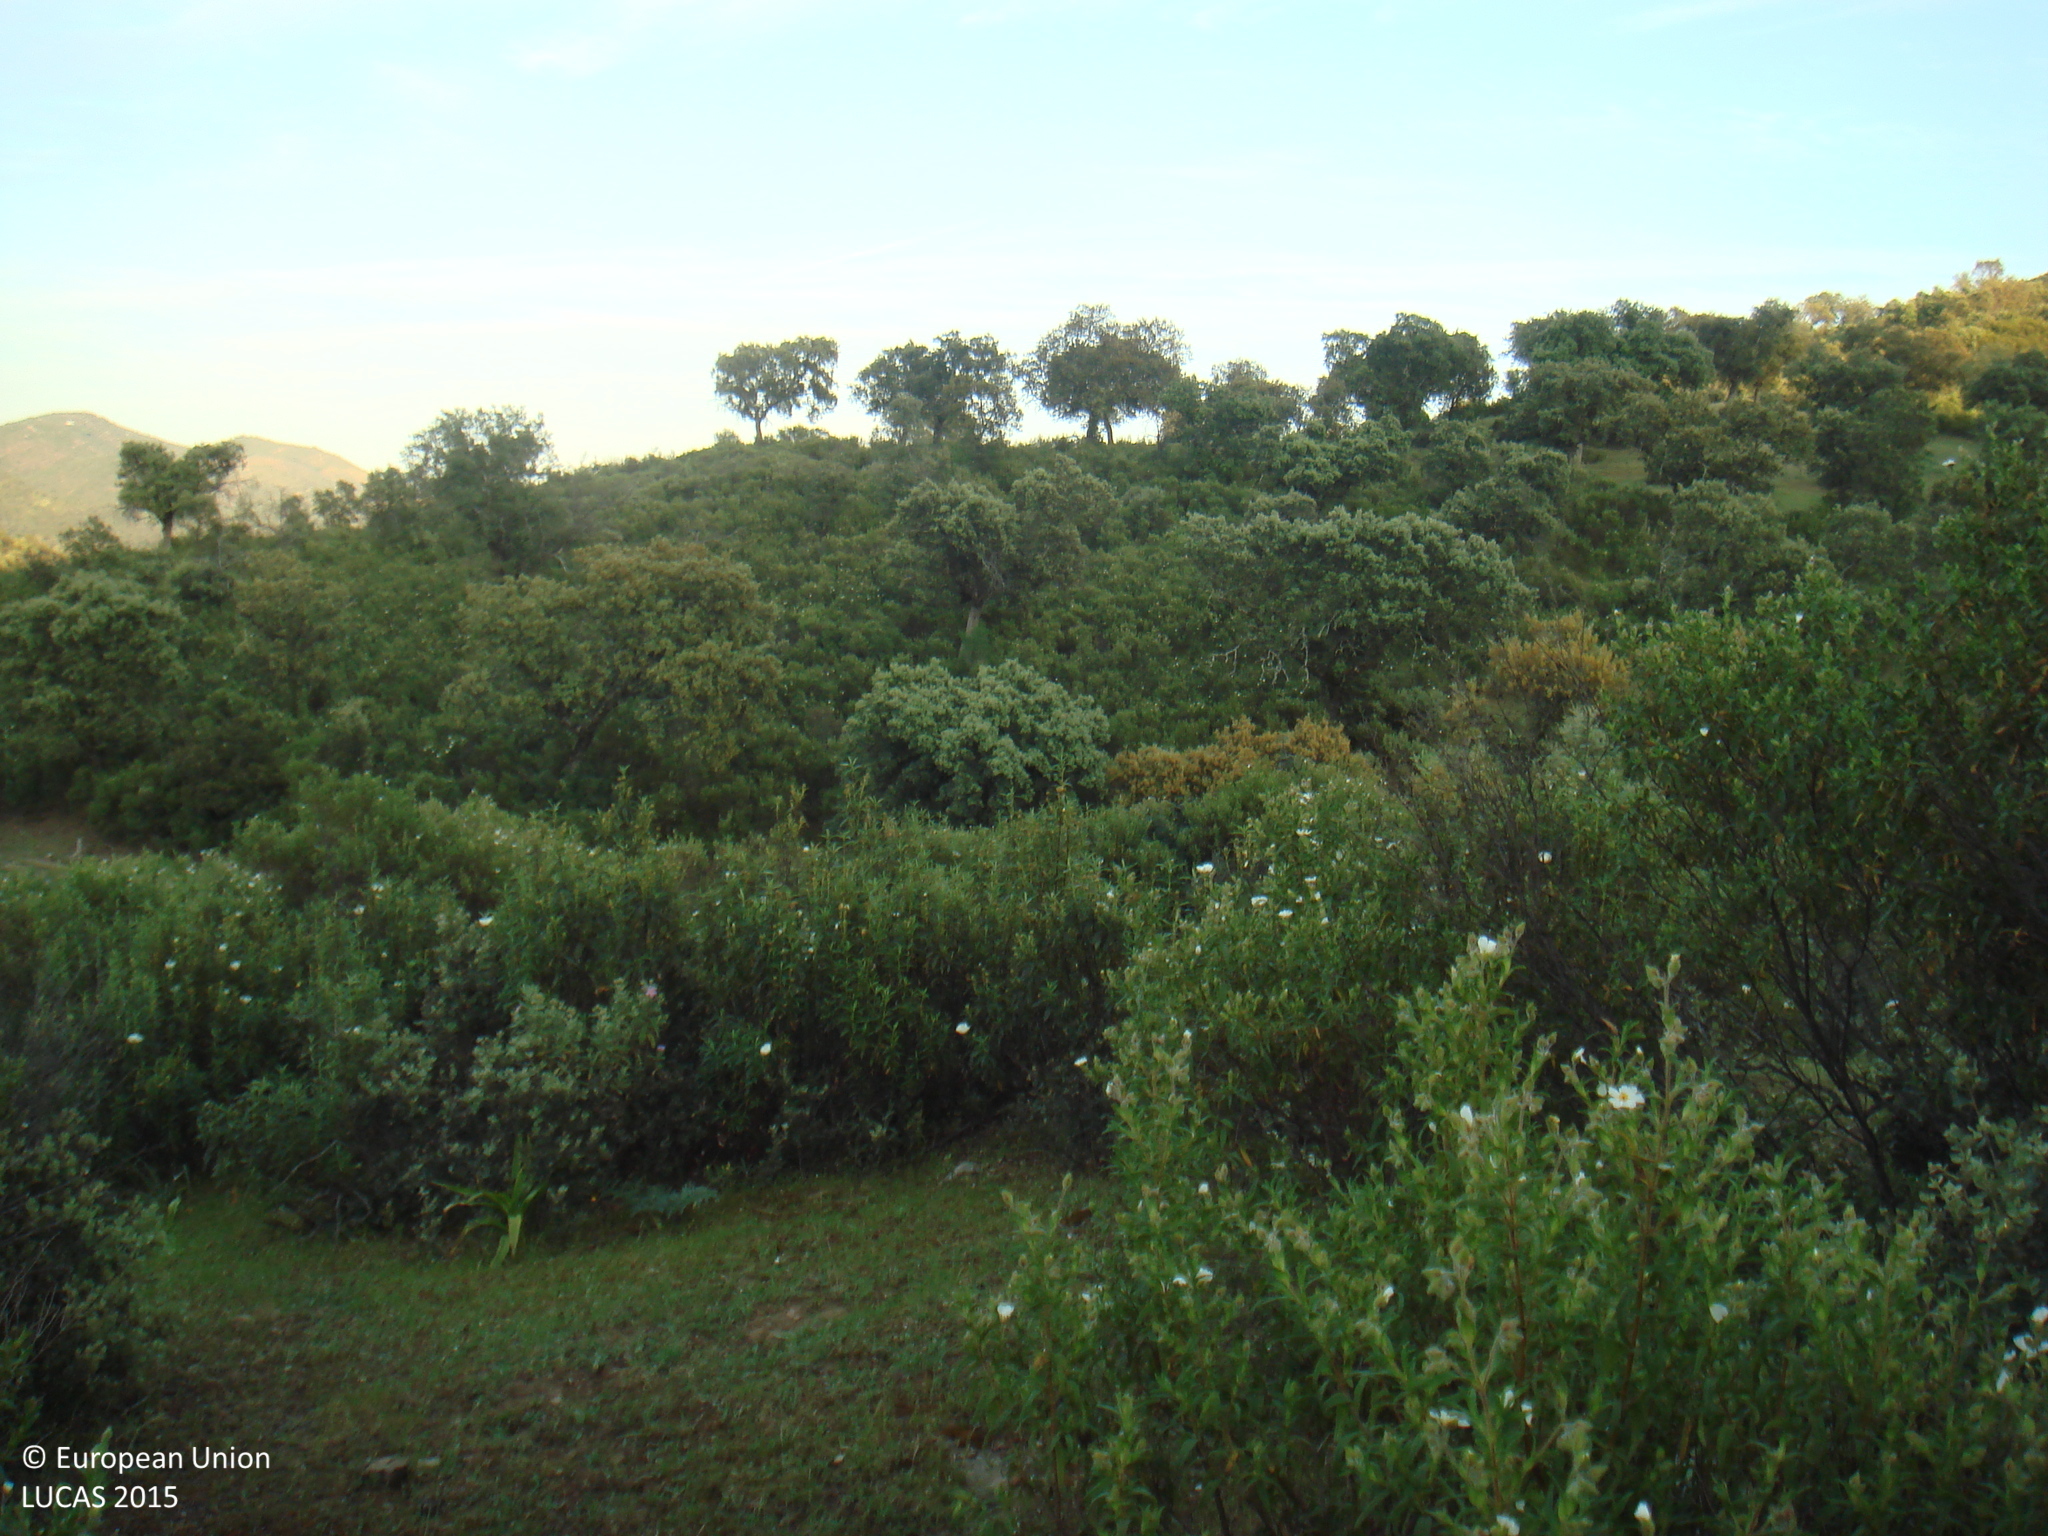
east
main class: Shrubland
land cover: Shrubland with sparse tree cover
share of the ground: 50 - 75 %
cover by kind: herbaceous plants 55 %, shrubs 40 %, broadleaved forest trees 5 %
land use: Forestry
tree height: > 5 m
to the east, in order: Shrubland with sparse tree cover; Other bare soil; Rivers and streams; Other bare soil; Shrubland with sparse tree cover; Other bare soil
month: April
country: ES
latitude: 38.0681
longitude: -4.7092
